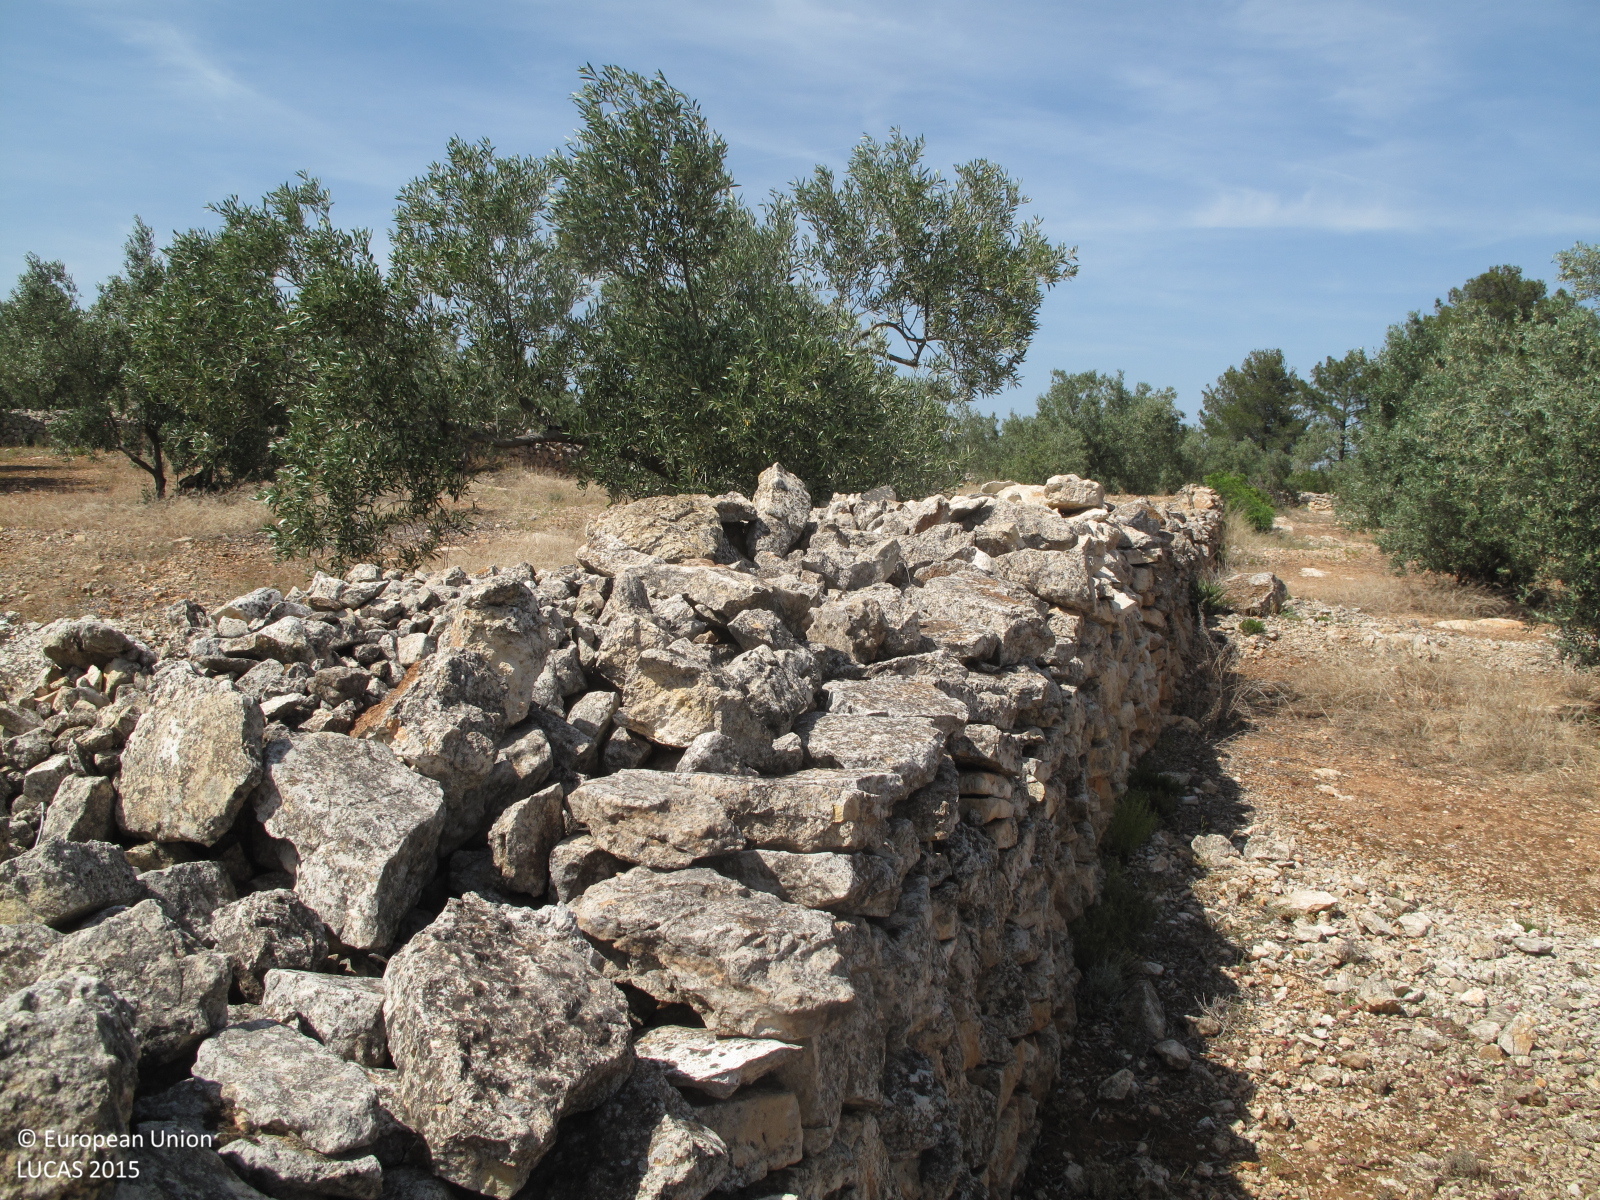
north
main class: Cropland
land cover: Olive groves
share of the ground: 10 - 25 %
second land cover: Spontaneously vegetated surfaces
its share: 25 - 50 %
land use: Agriculture (excluding fallow land and kitchen gardens)
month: May
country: ES
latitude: 38.9825
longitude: -0.7410
